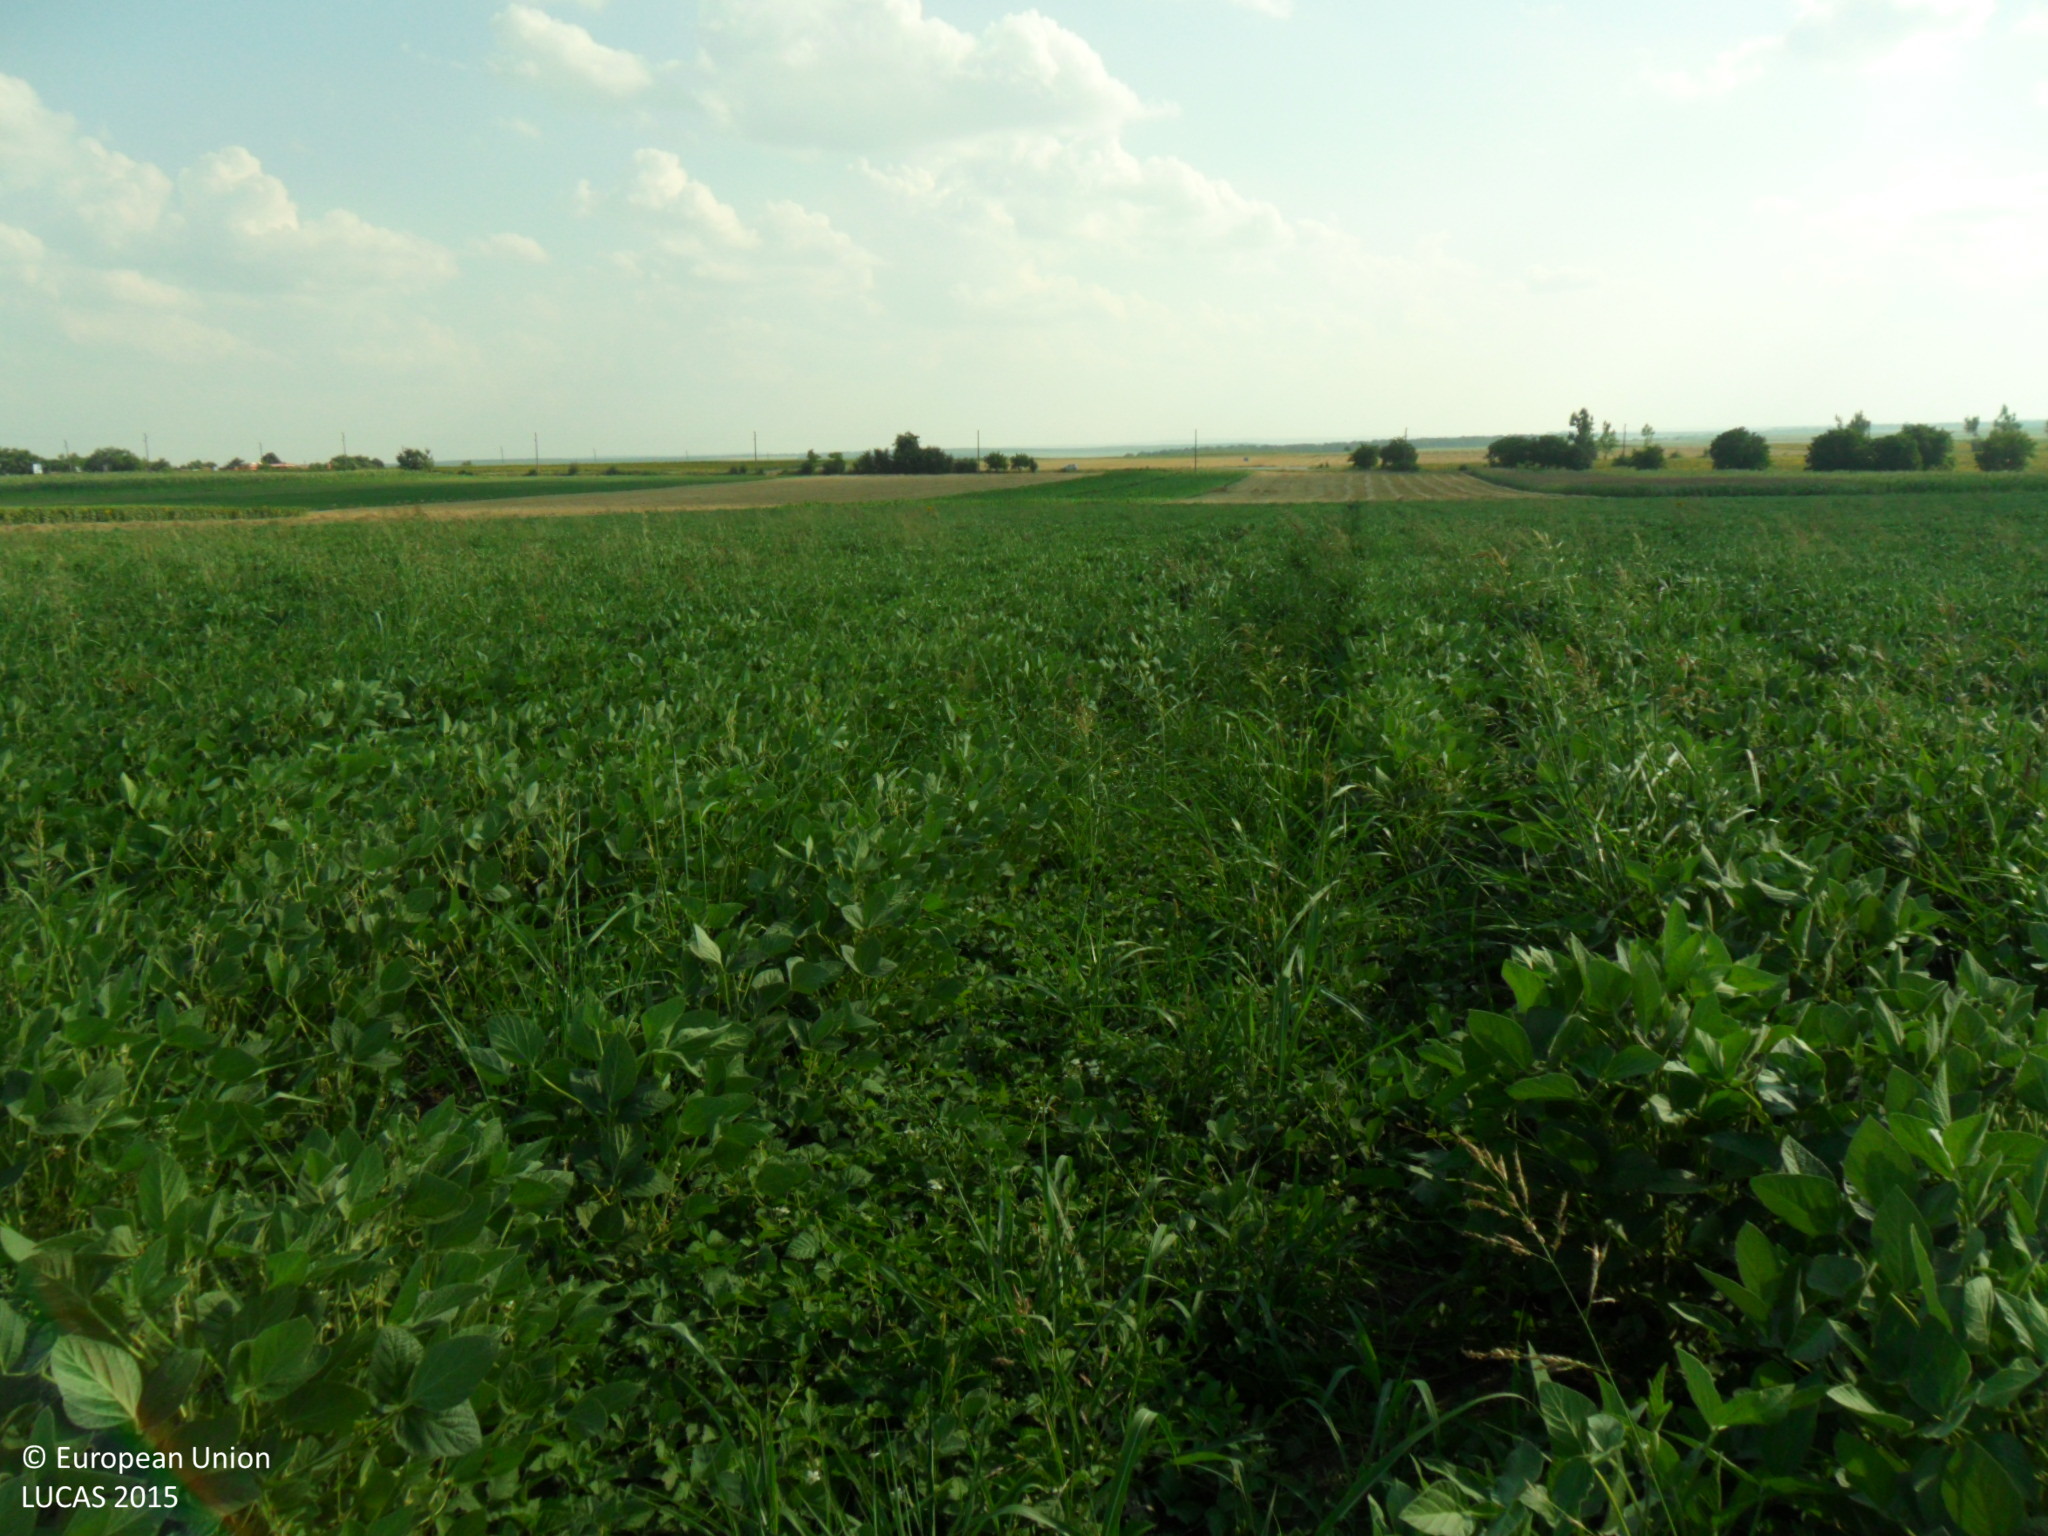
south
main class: Cropland
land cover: Soya
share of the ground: > 75 %
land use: Agriculture (excluding fallow land and kitchen gardens)
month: July
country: BG
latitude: 43.6592
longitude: 27.0722
